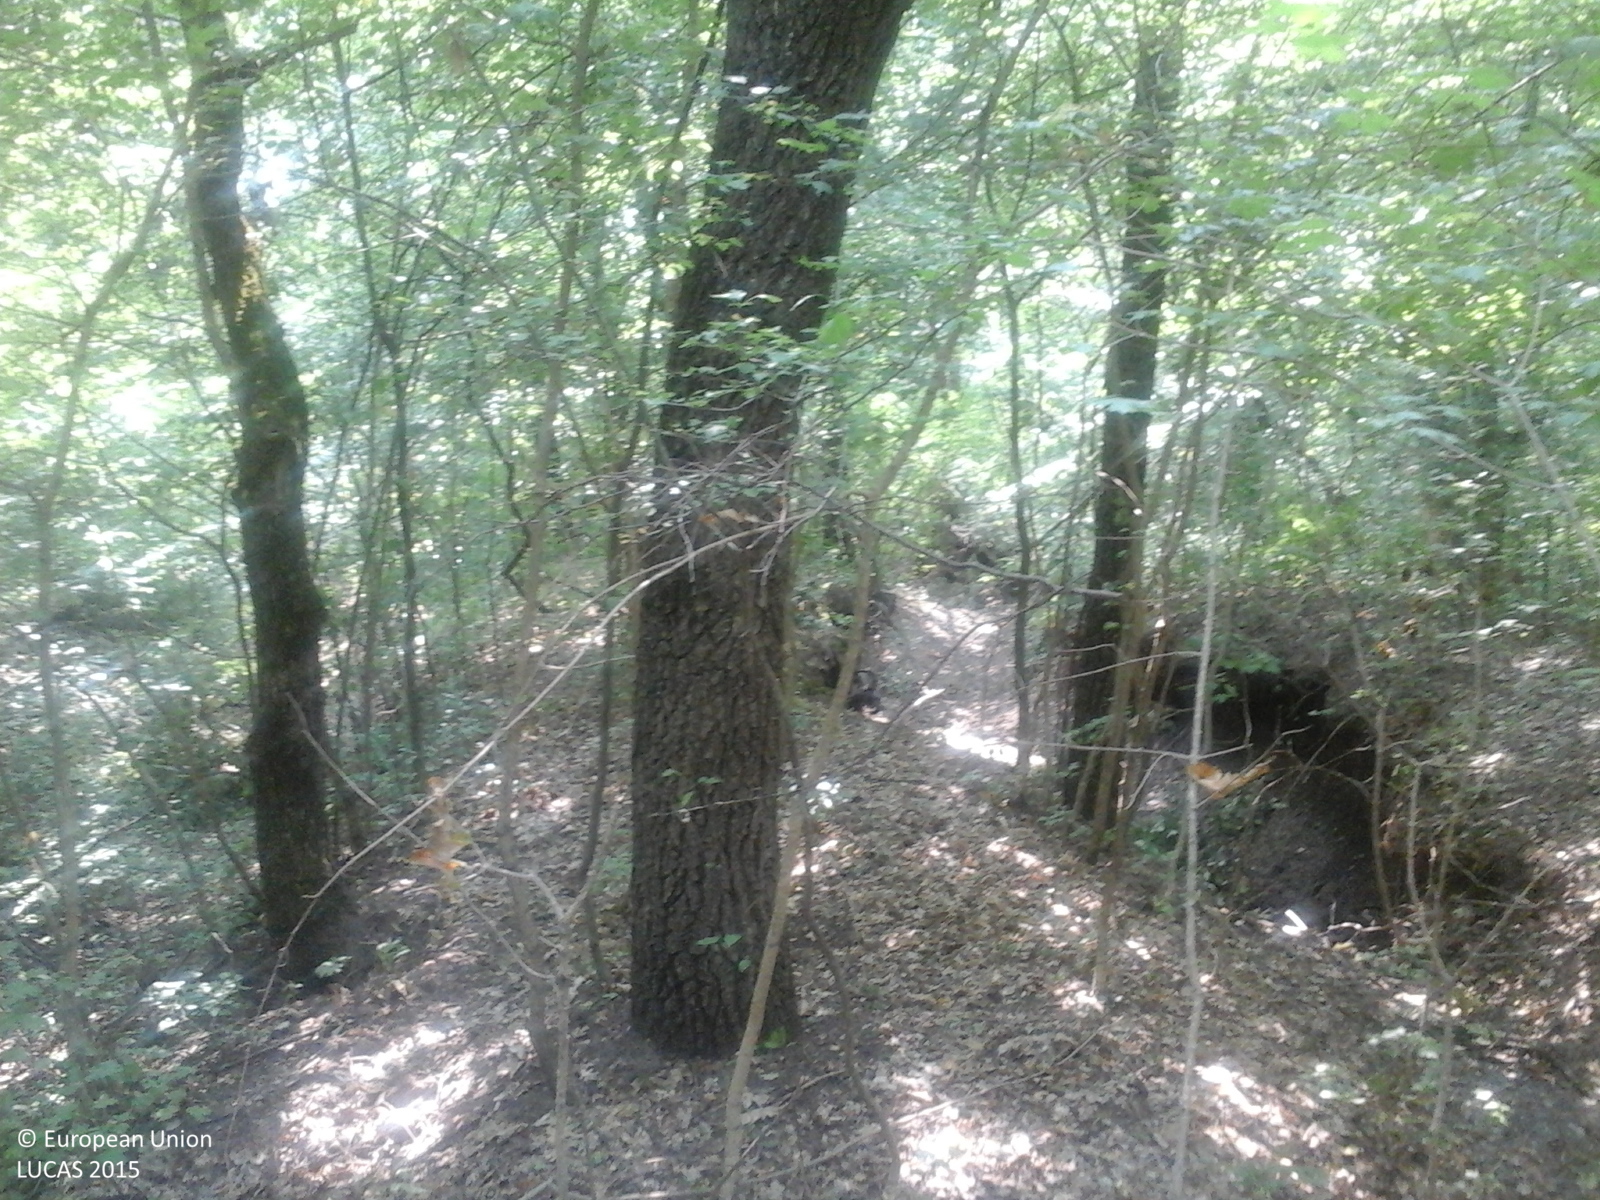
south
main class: Woodland
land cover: Broadleaved woodland
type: acidophilous oak and oak-birch forest
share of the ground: > 75 %
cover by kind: broadleaved forest trees 100 %
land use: Forestry
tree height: > 5 m
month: July
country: RO
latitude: 46.3910
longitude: 27.5770
